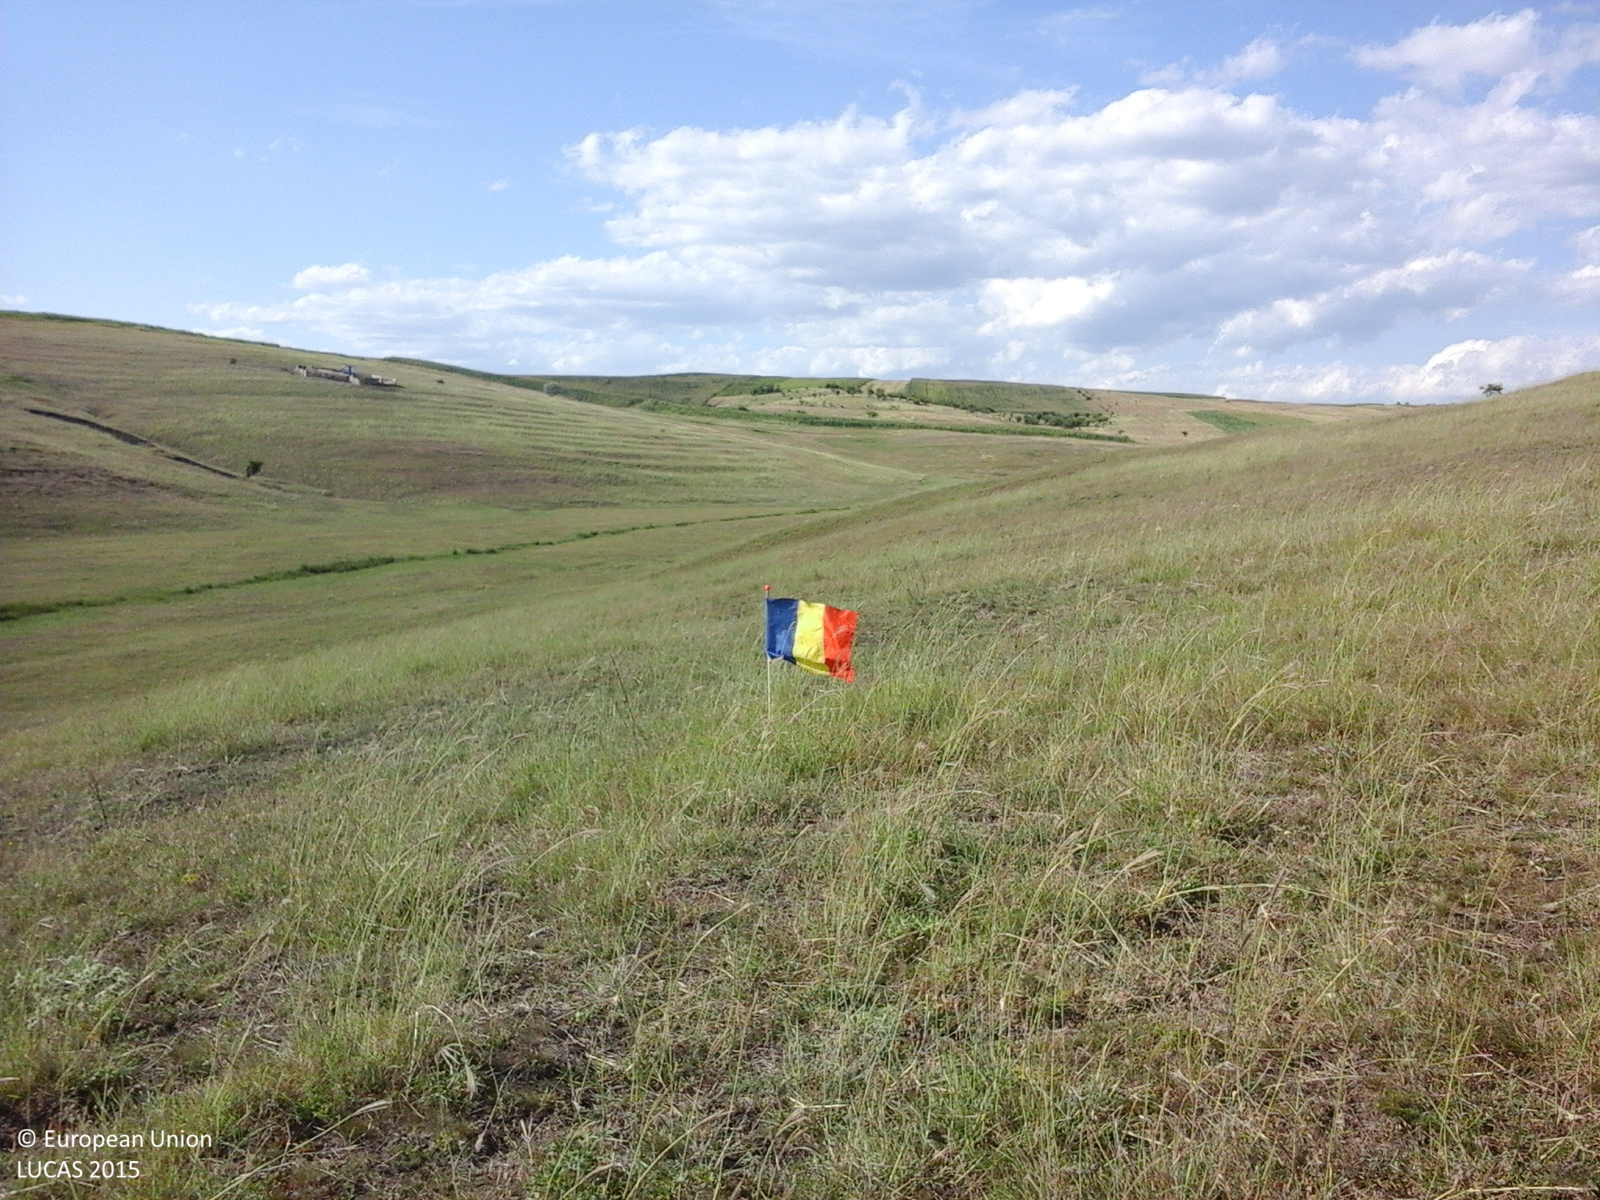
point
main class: Grassland
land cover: Grassland without tree/shrub cover
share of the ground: > 75 %
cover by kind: herbaceous plants 100 %
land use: Agriculture (excluding fallow land and kitchen gardens)
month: July
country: RO
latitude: 46.0258
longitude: 27.6682
